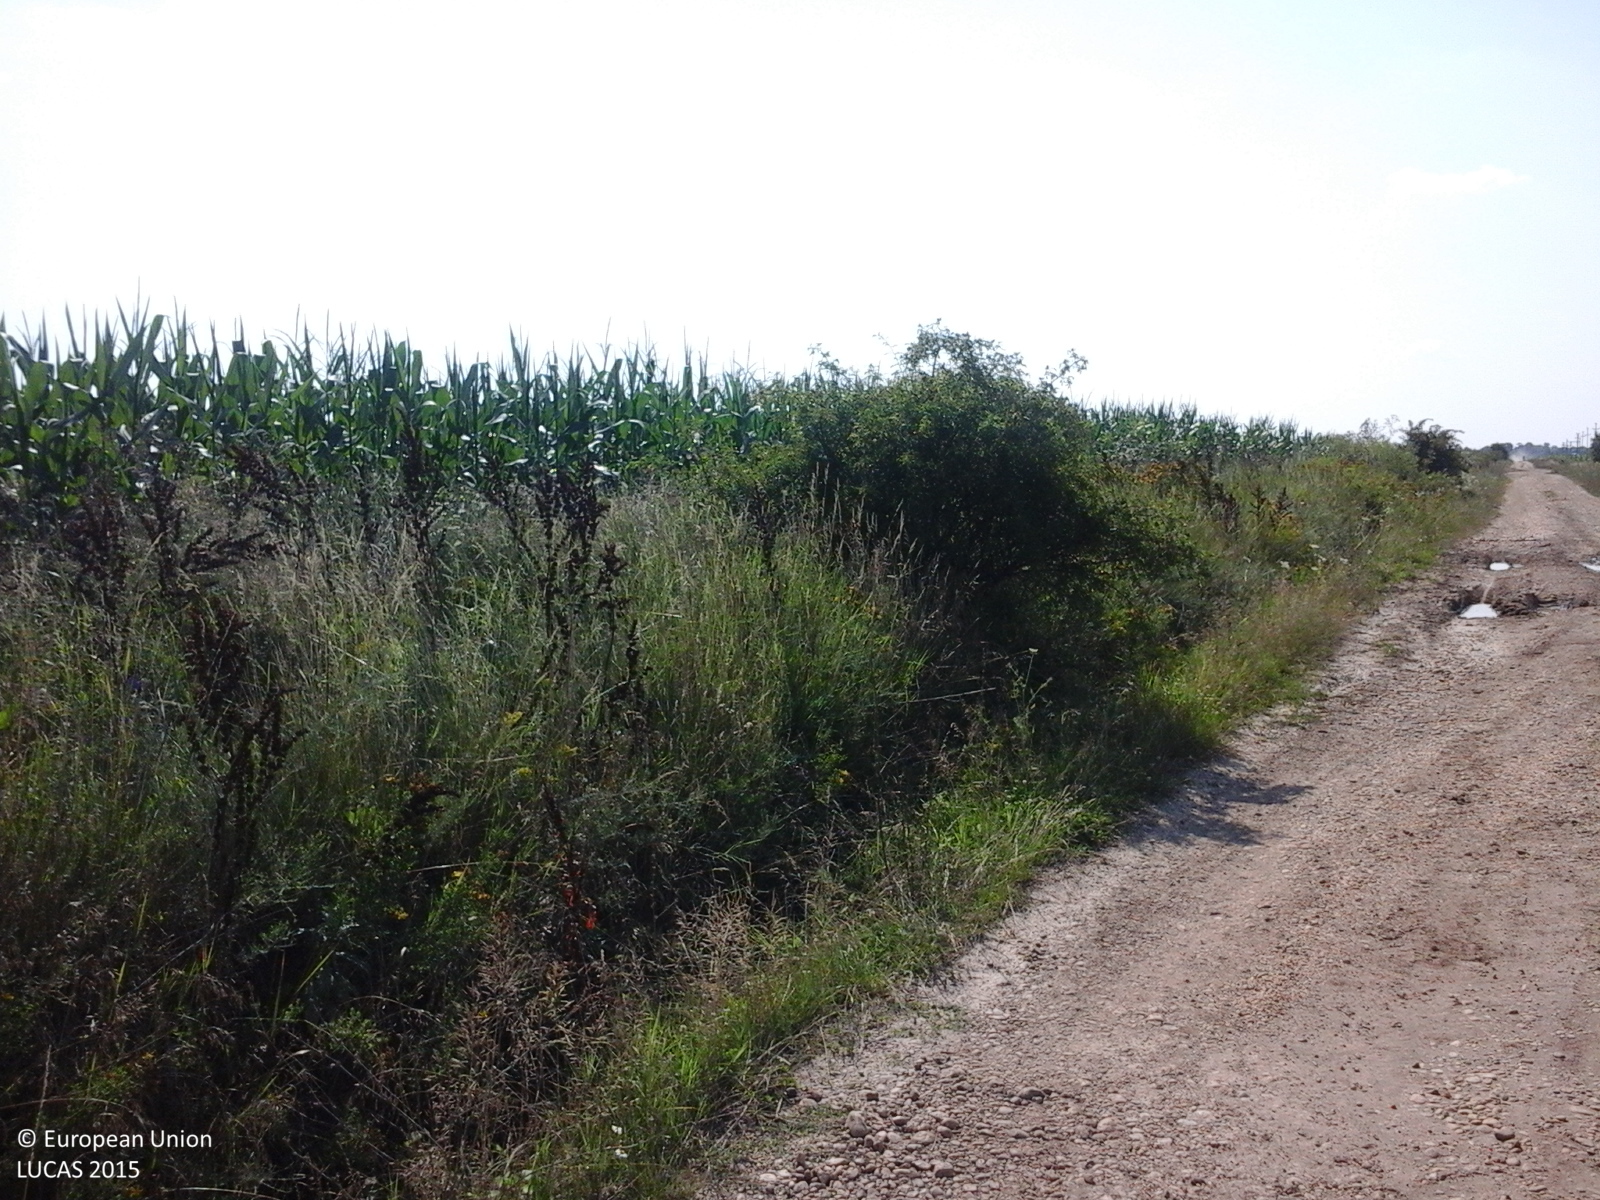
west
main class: Cropland
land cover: Common wheat
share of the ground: > 75 %
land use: Agriculture (excluding fallow land and kitchen gardens)
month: July
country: RO
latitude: 44.5749
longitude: 24.9790
